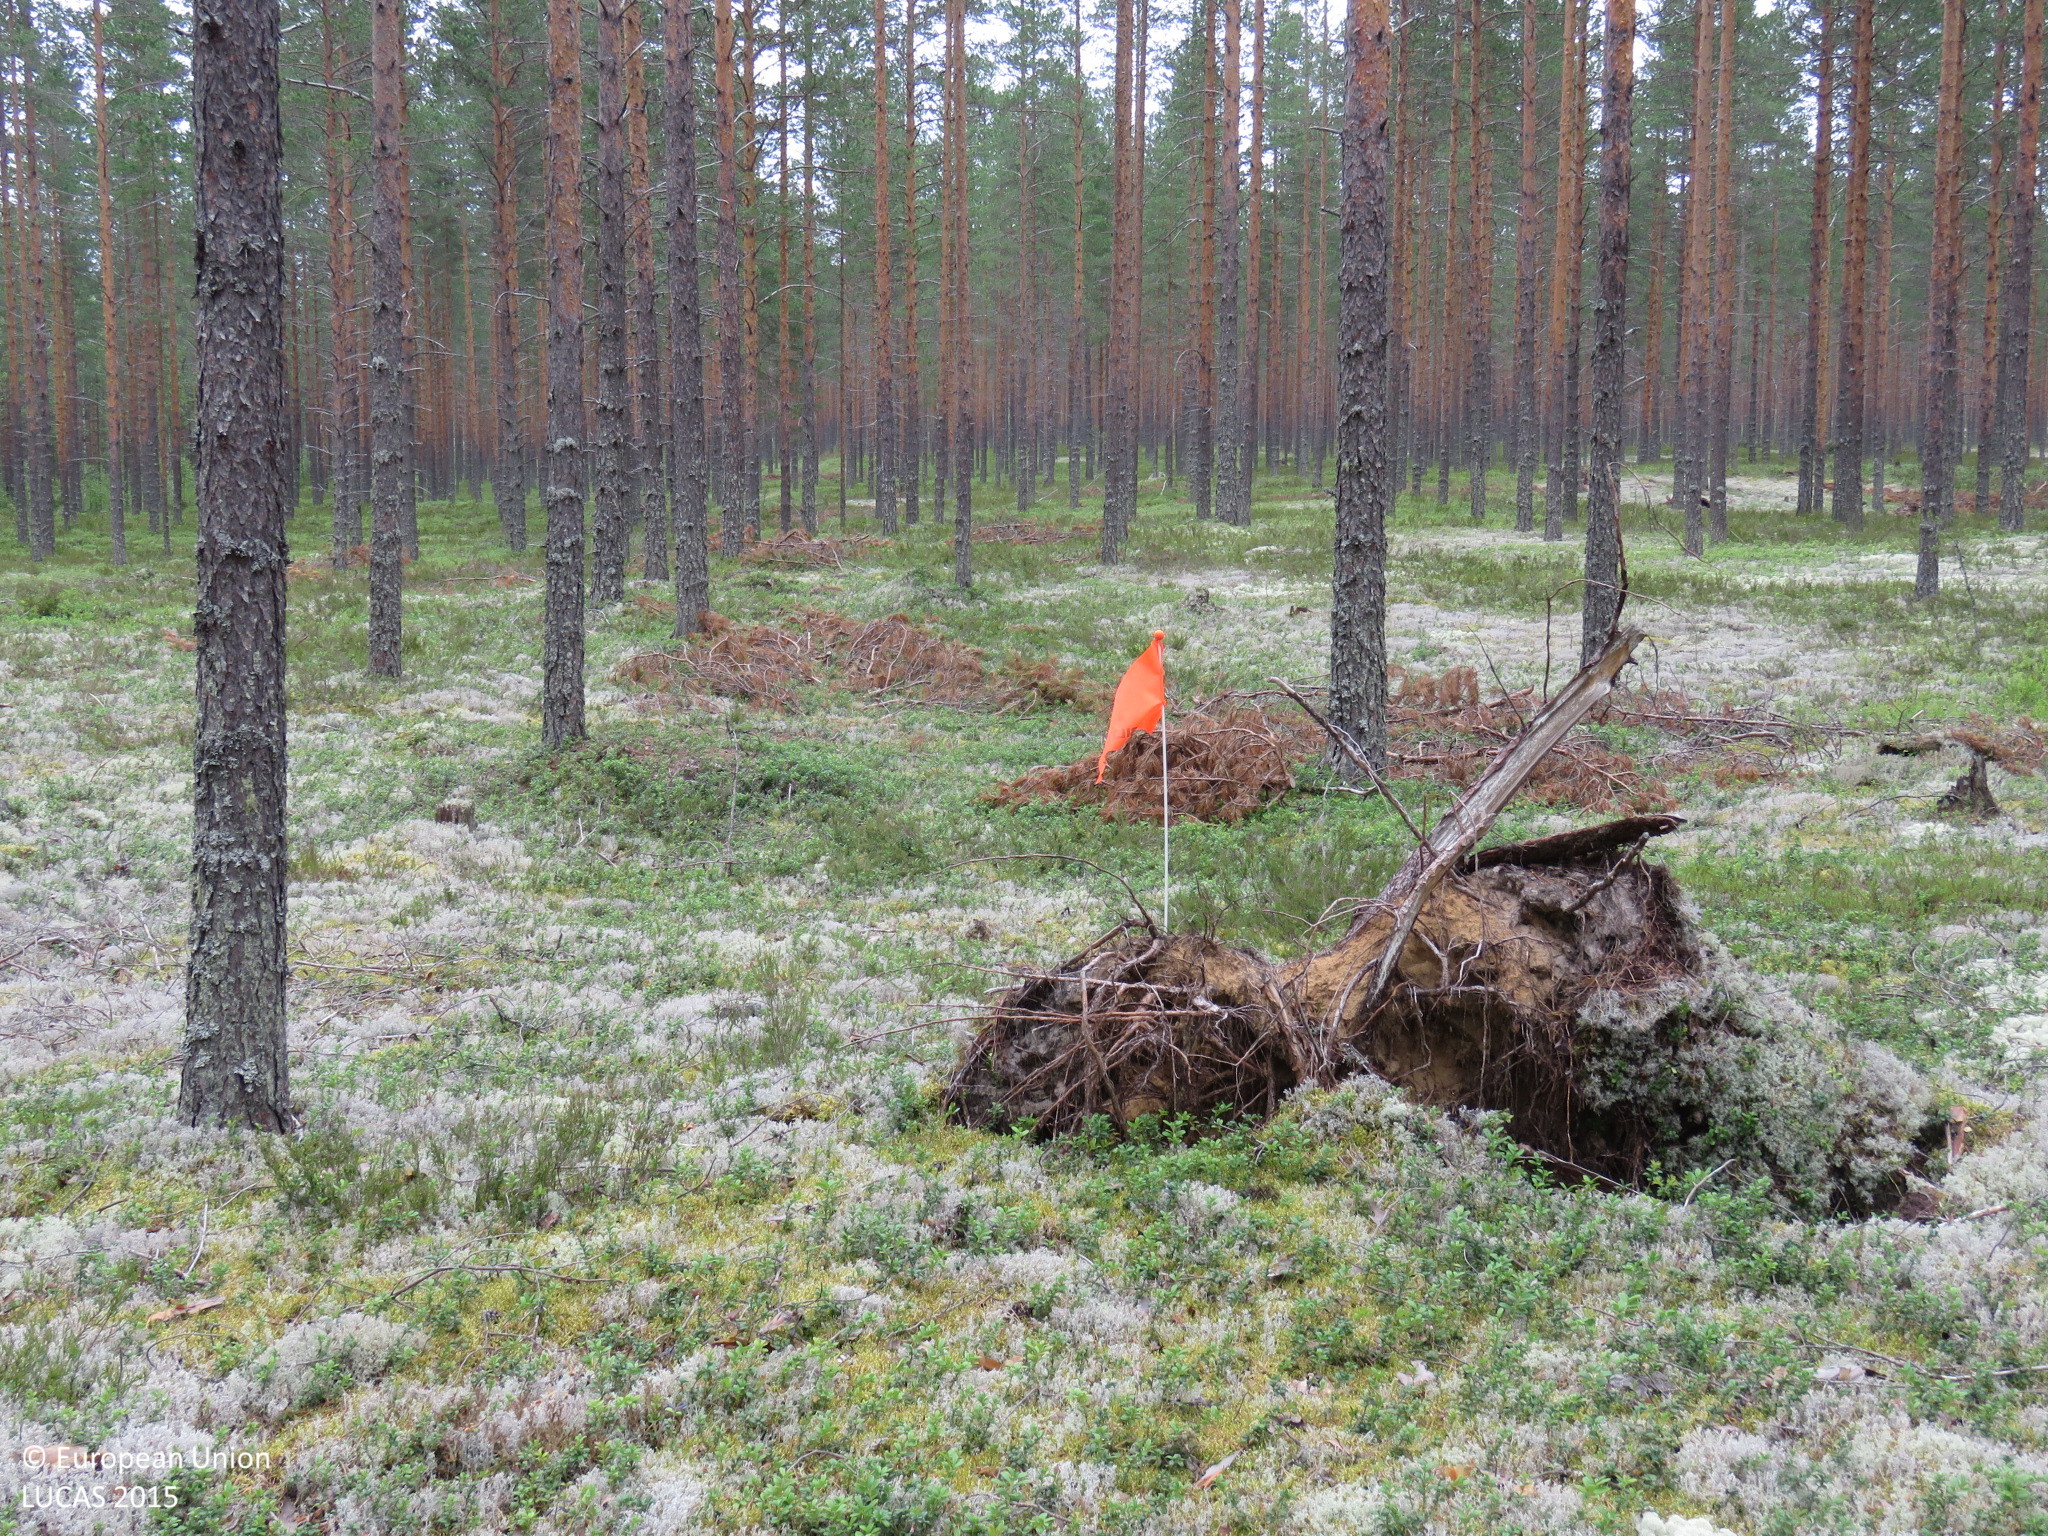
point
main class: Woodland
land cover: Pine dominated coniferous woodland
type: boreal forest
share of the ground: > 75 %
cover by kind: coniferous forest trees 75 %, lichens and mosses 15 %, shrubs 10 %
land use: Forestry
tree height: > 5 m
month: July
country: FI
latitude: 64.2591
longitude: 26.3975
